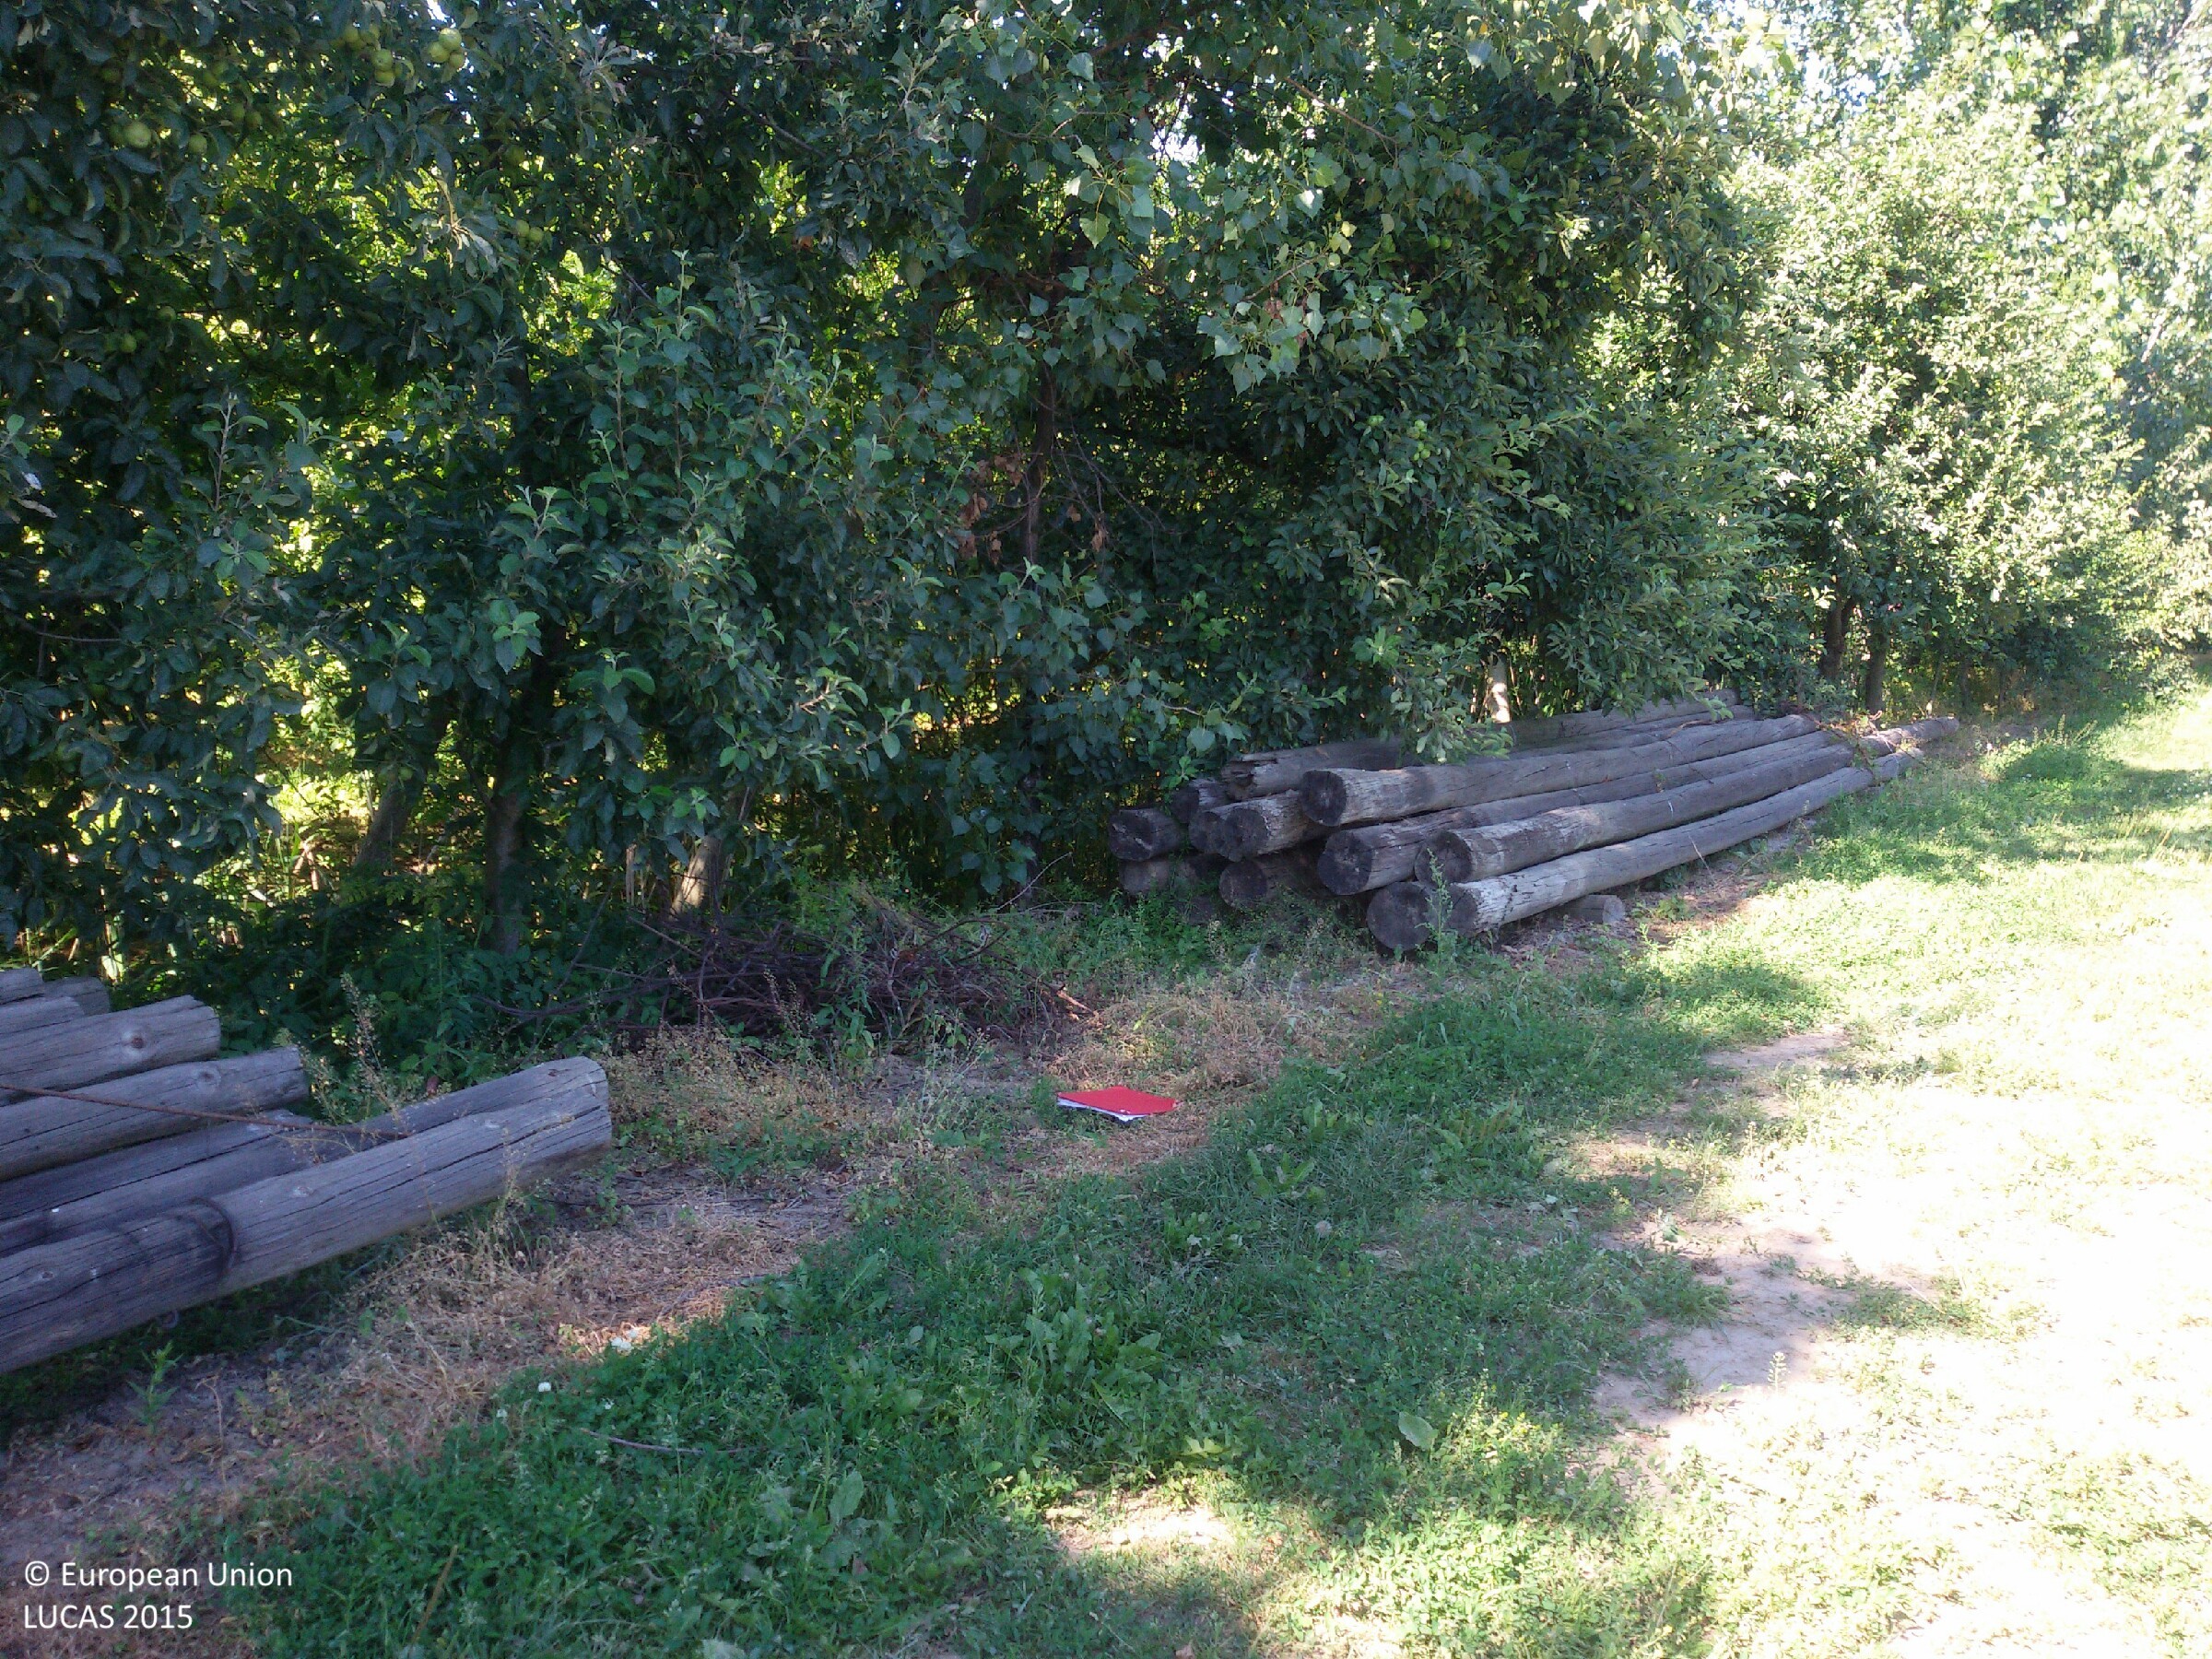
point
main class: Cropland
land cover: Apple fruit
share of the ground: 50 - 75 %
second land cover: Grassland without tree/shrub cover
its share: 50 - 75 %
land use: Agriculture (excluding fallow land and kitchen gardens)
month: July
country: PL
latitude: 51.2367
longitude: 21.8438
